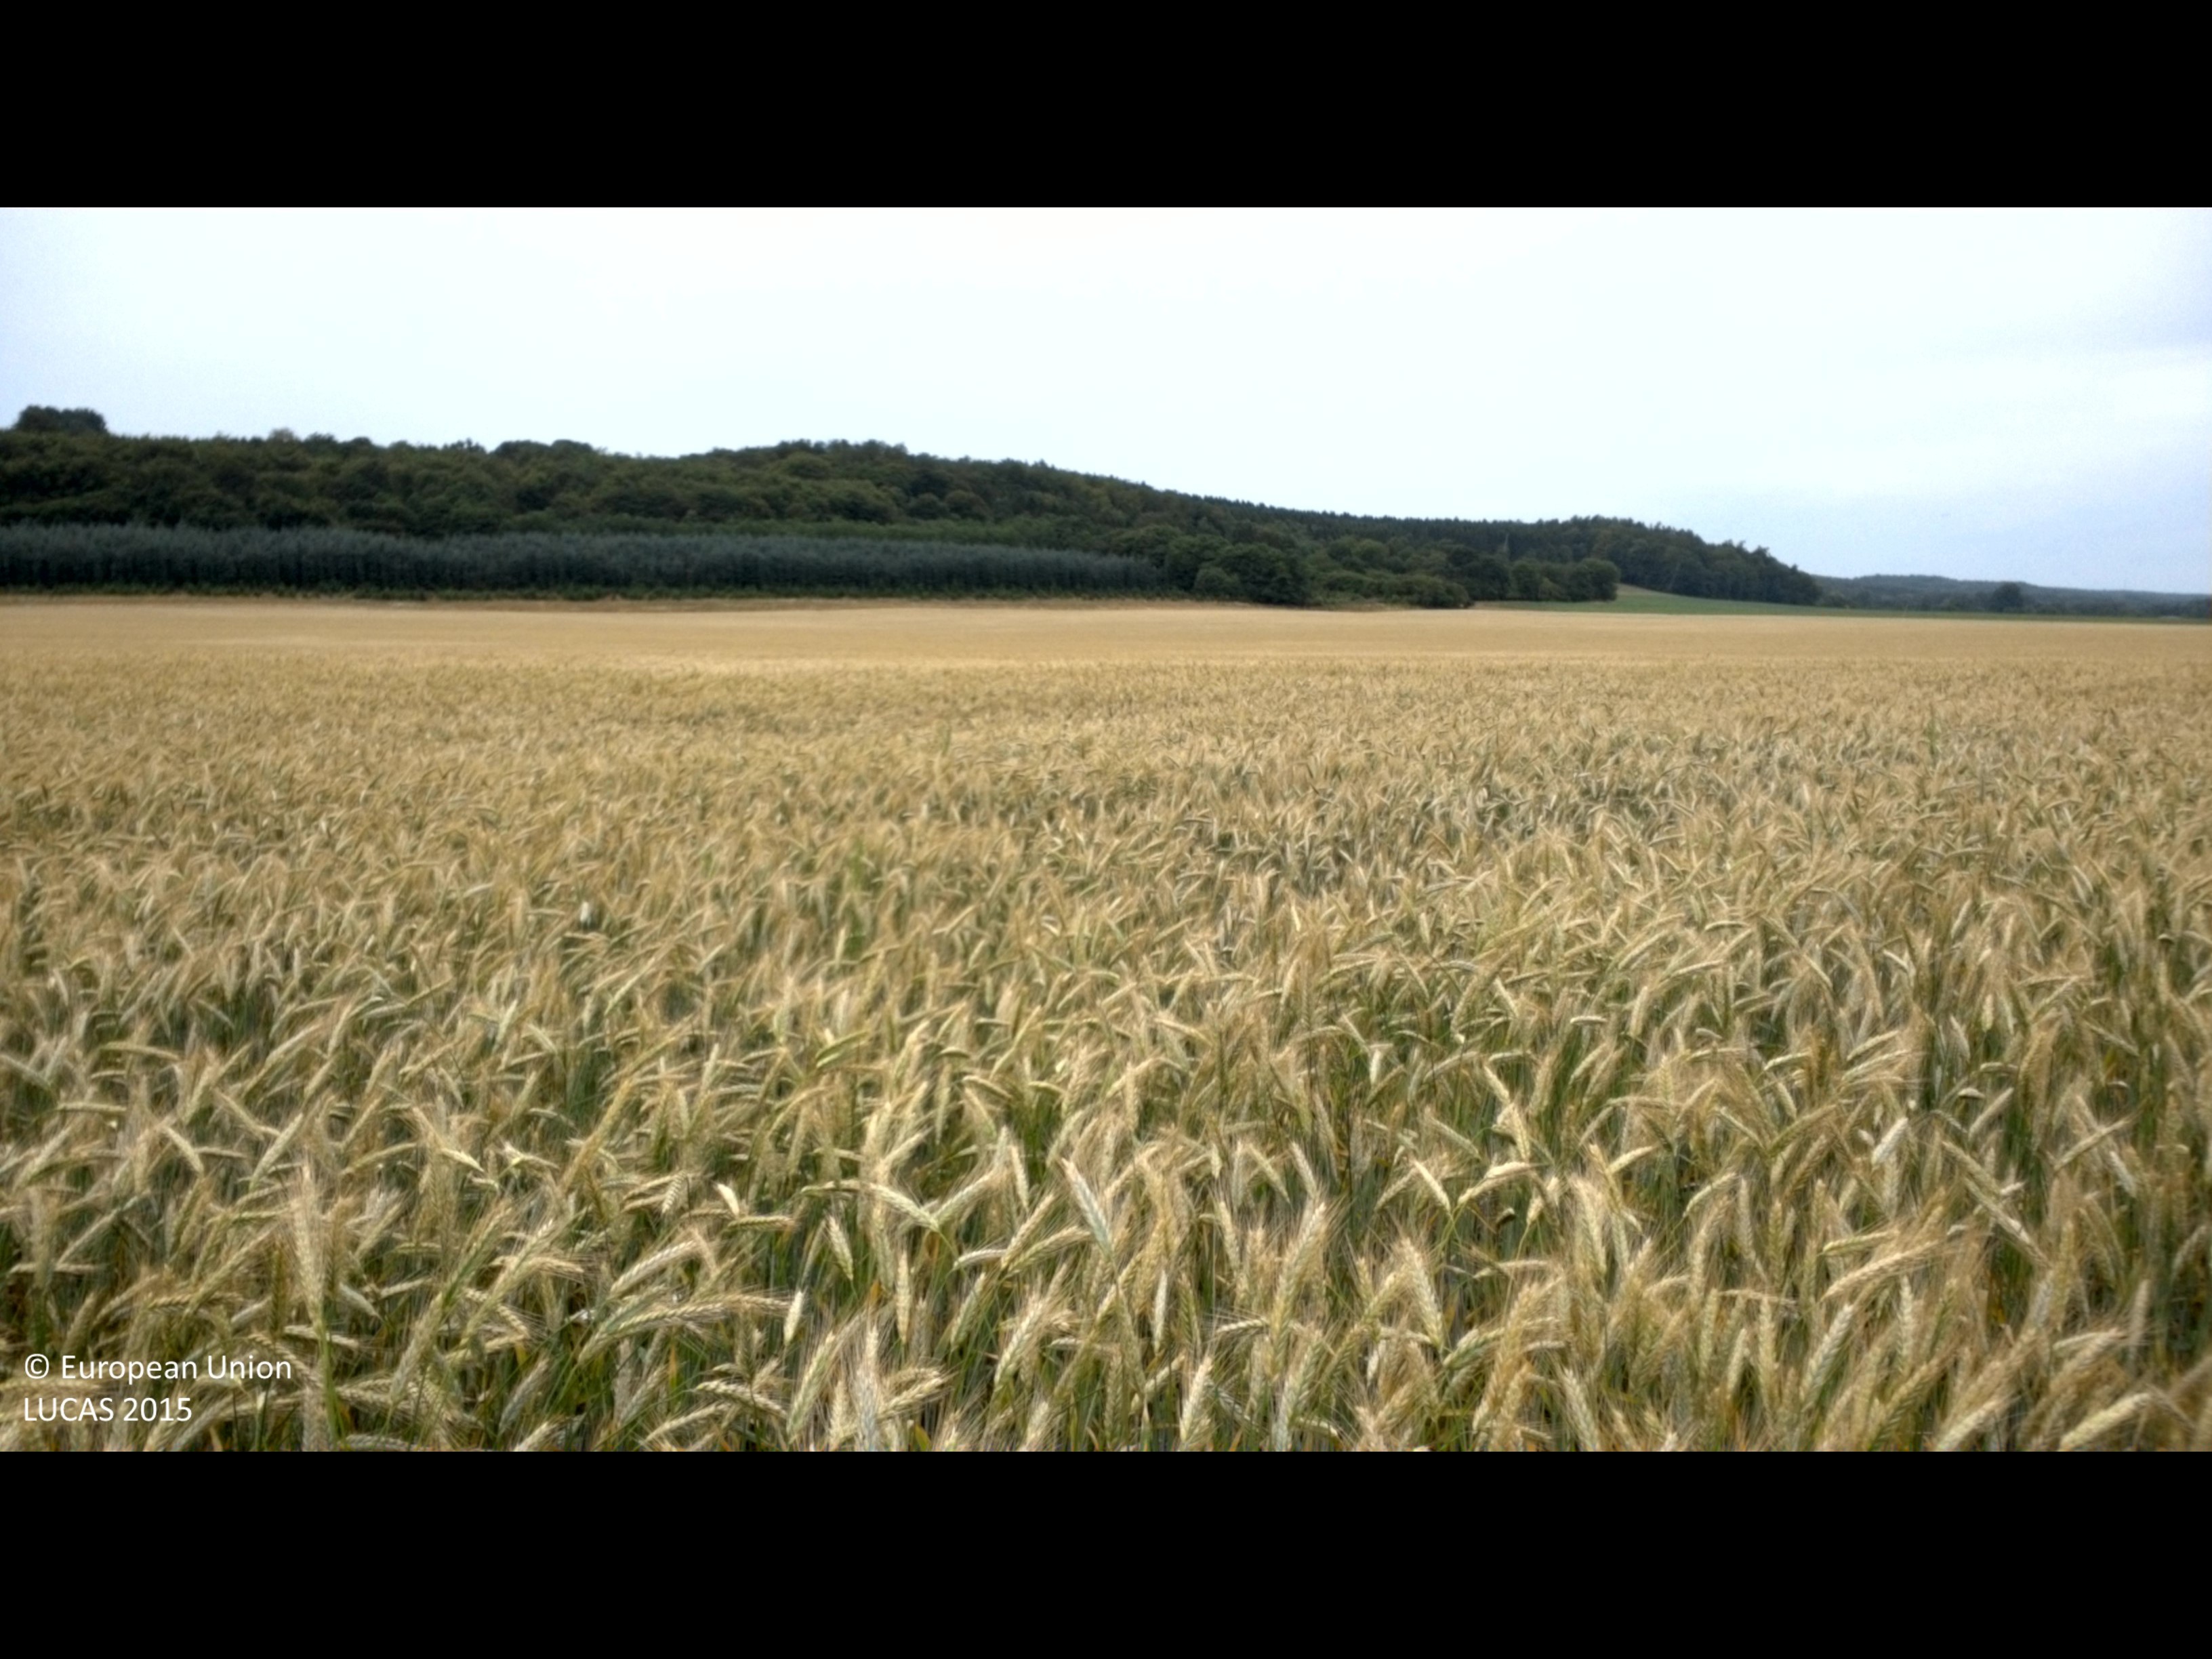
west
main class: Cropland
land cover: Rye
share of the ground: > 75 %
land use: Agriculture (excluding fallow land and kitchen gardens)
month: July
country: SE
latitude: 55.8532
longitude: 14.0715
